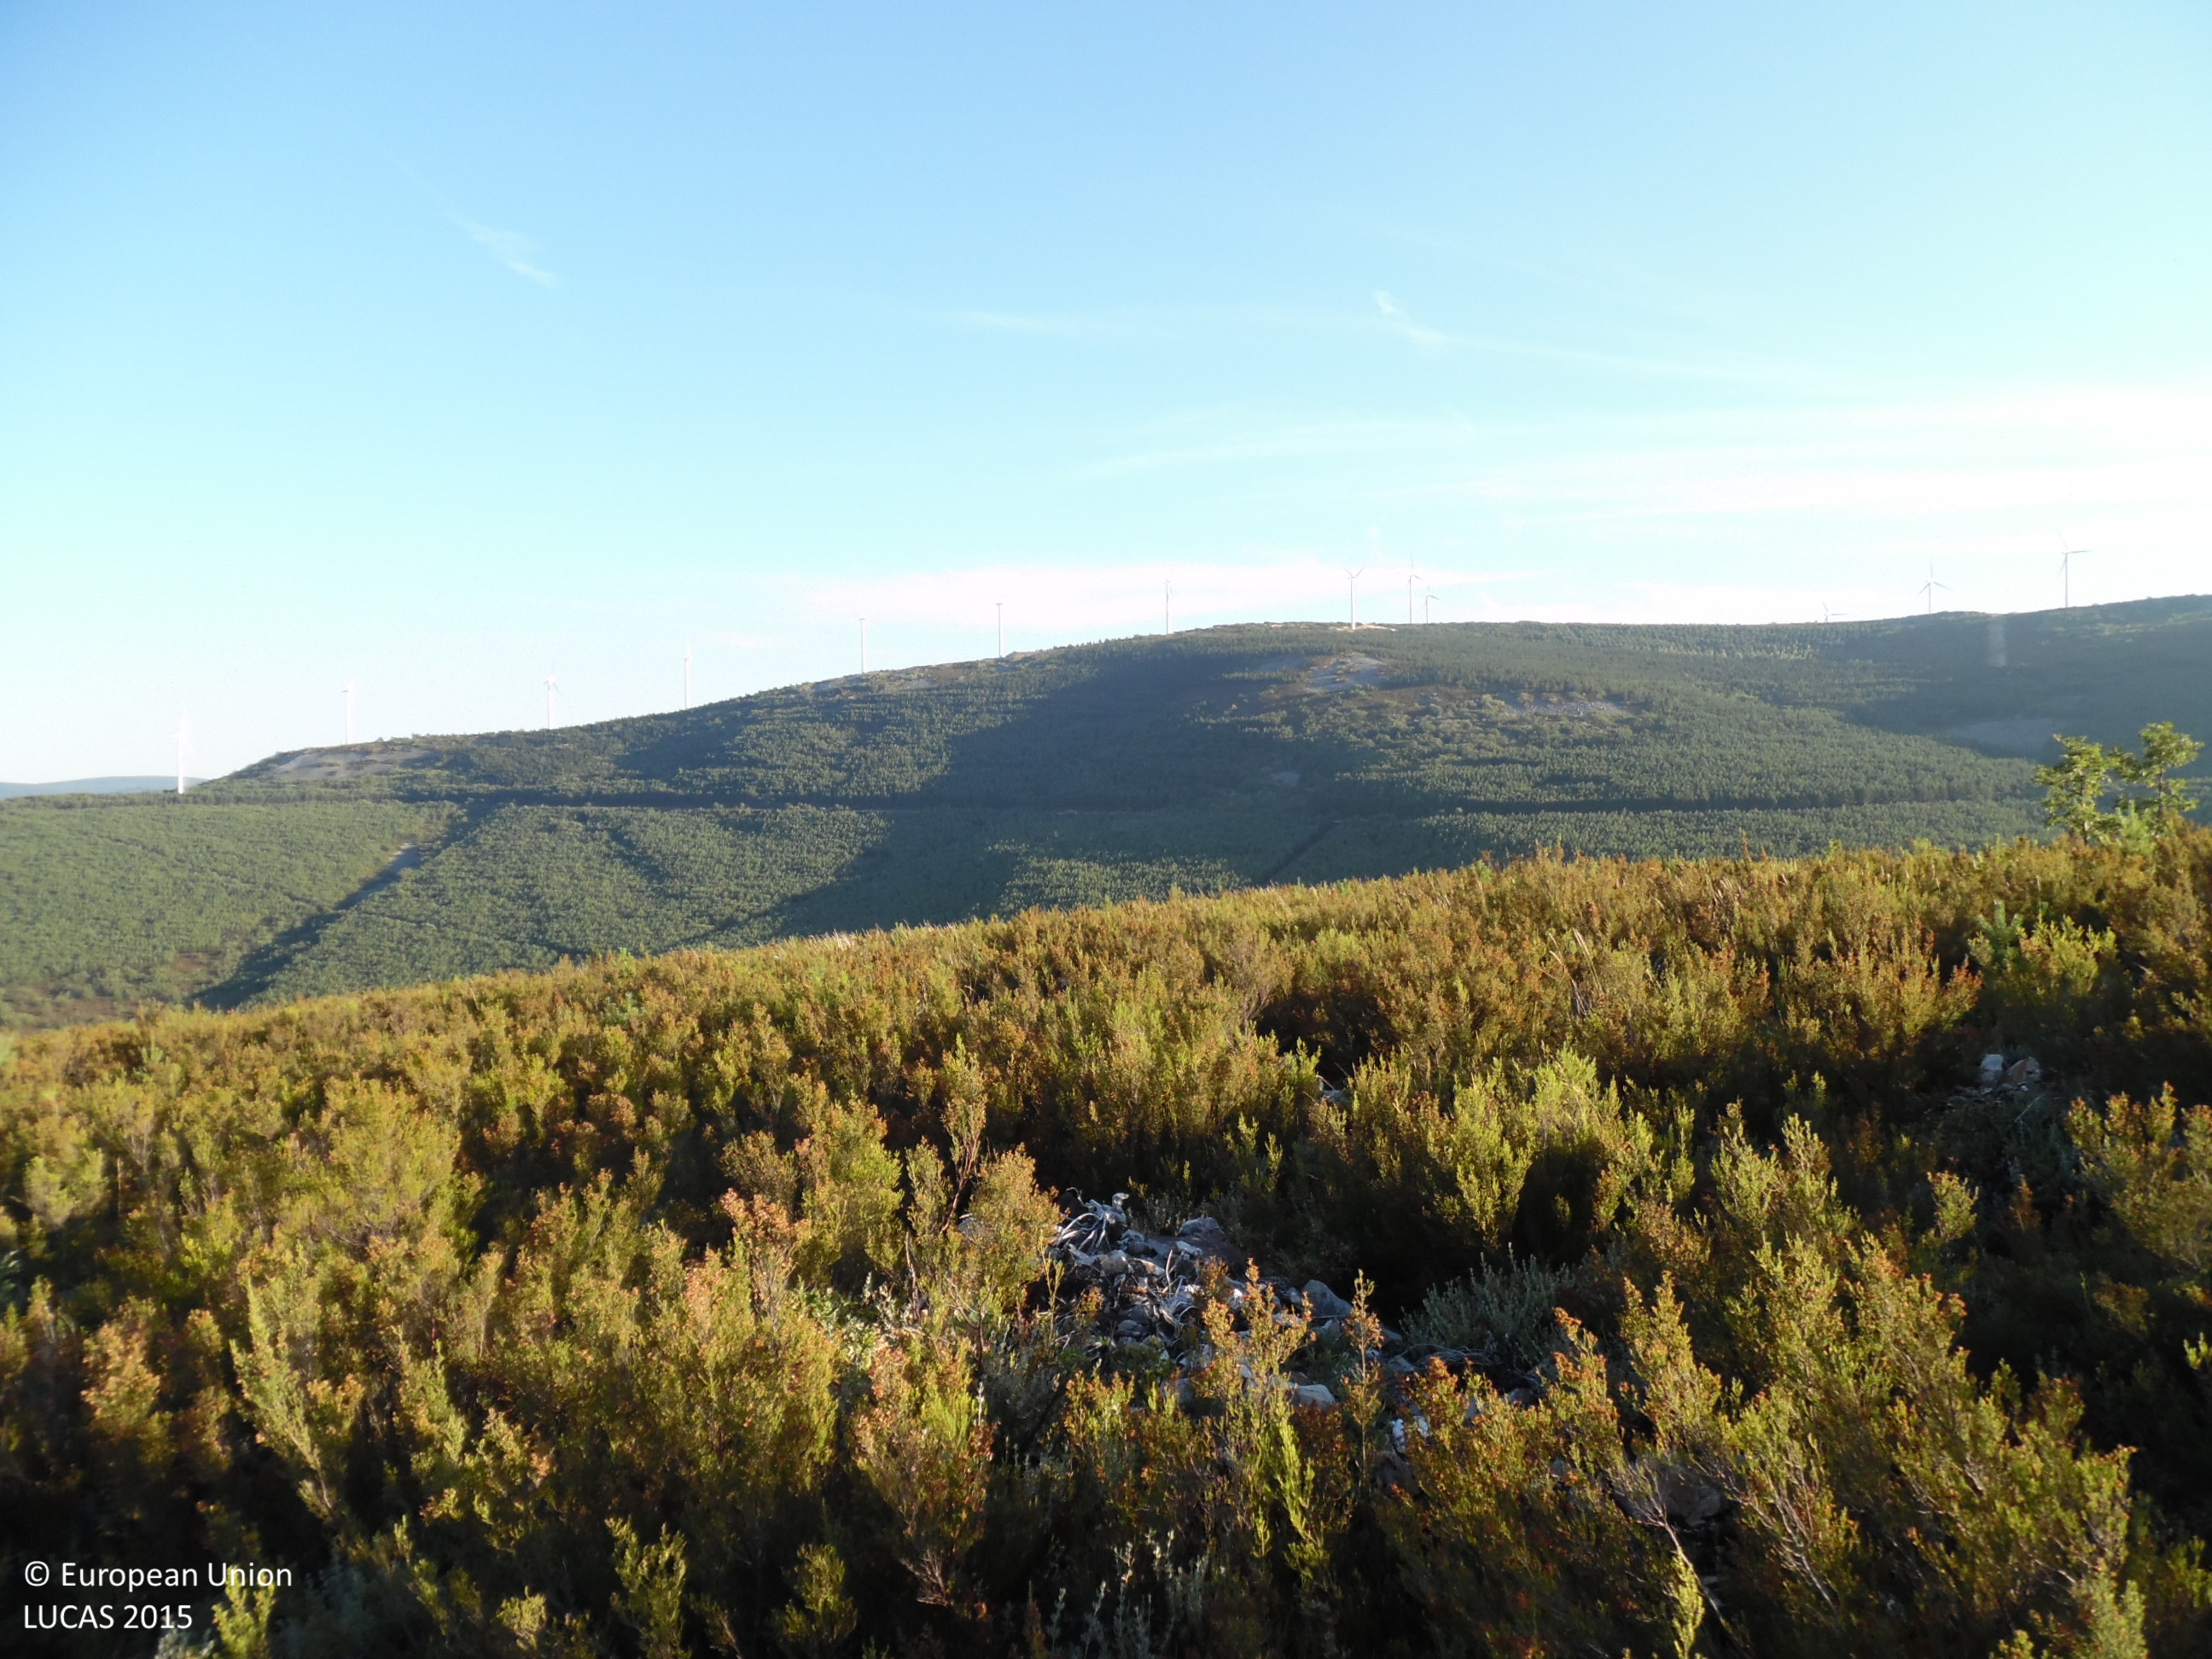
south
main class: Shrubland
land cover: Shrubland without tree cover
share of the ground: > 75 %
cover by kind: shrubs 100 %
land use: Forestry
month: July
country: ES
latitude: 42.5572
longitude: -6.3992
